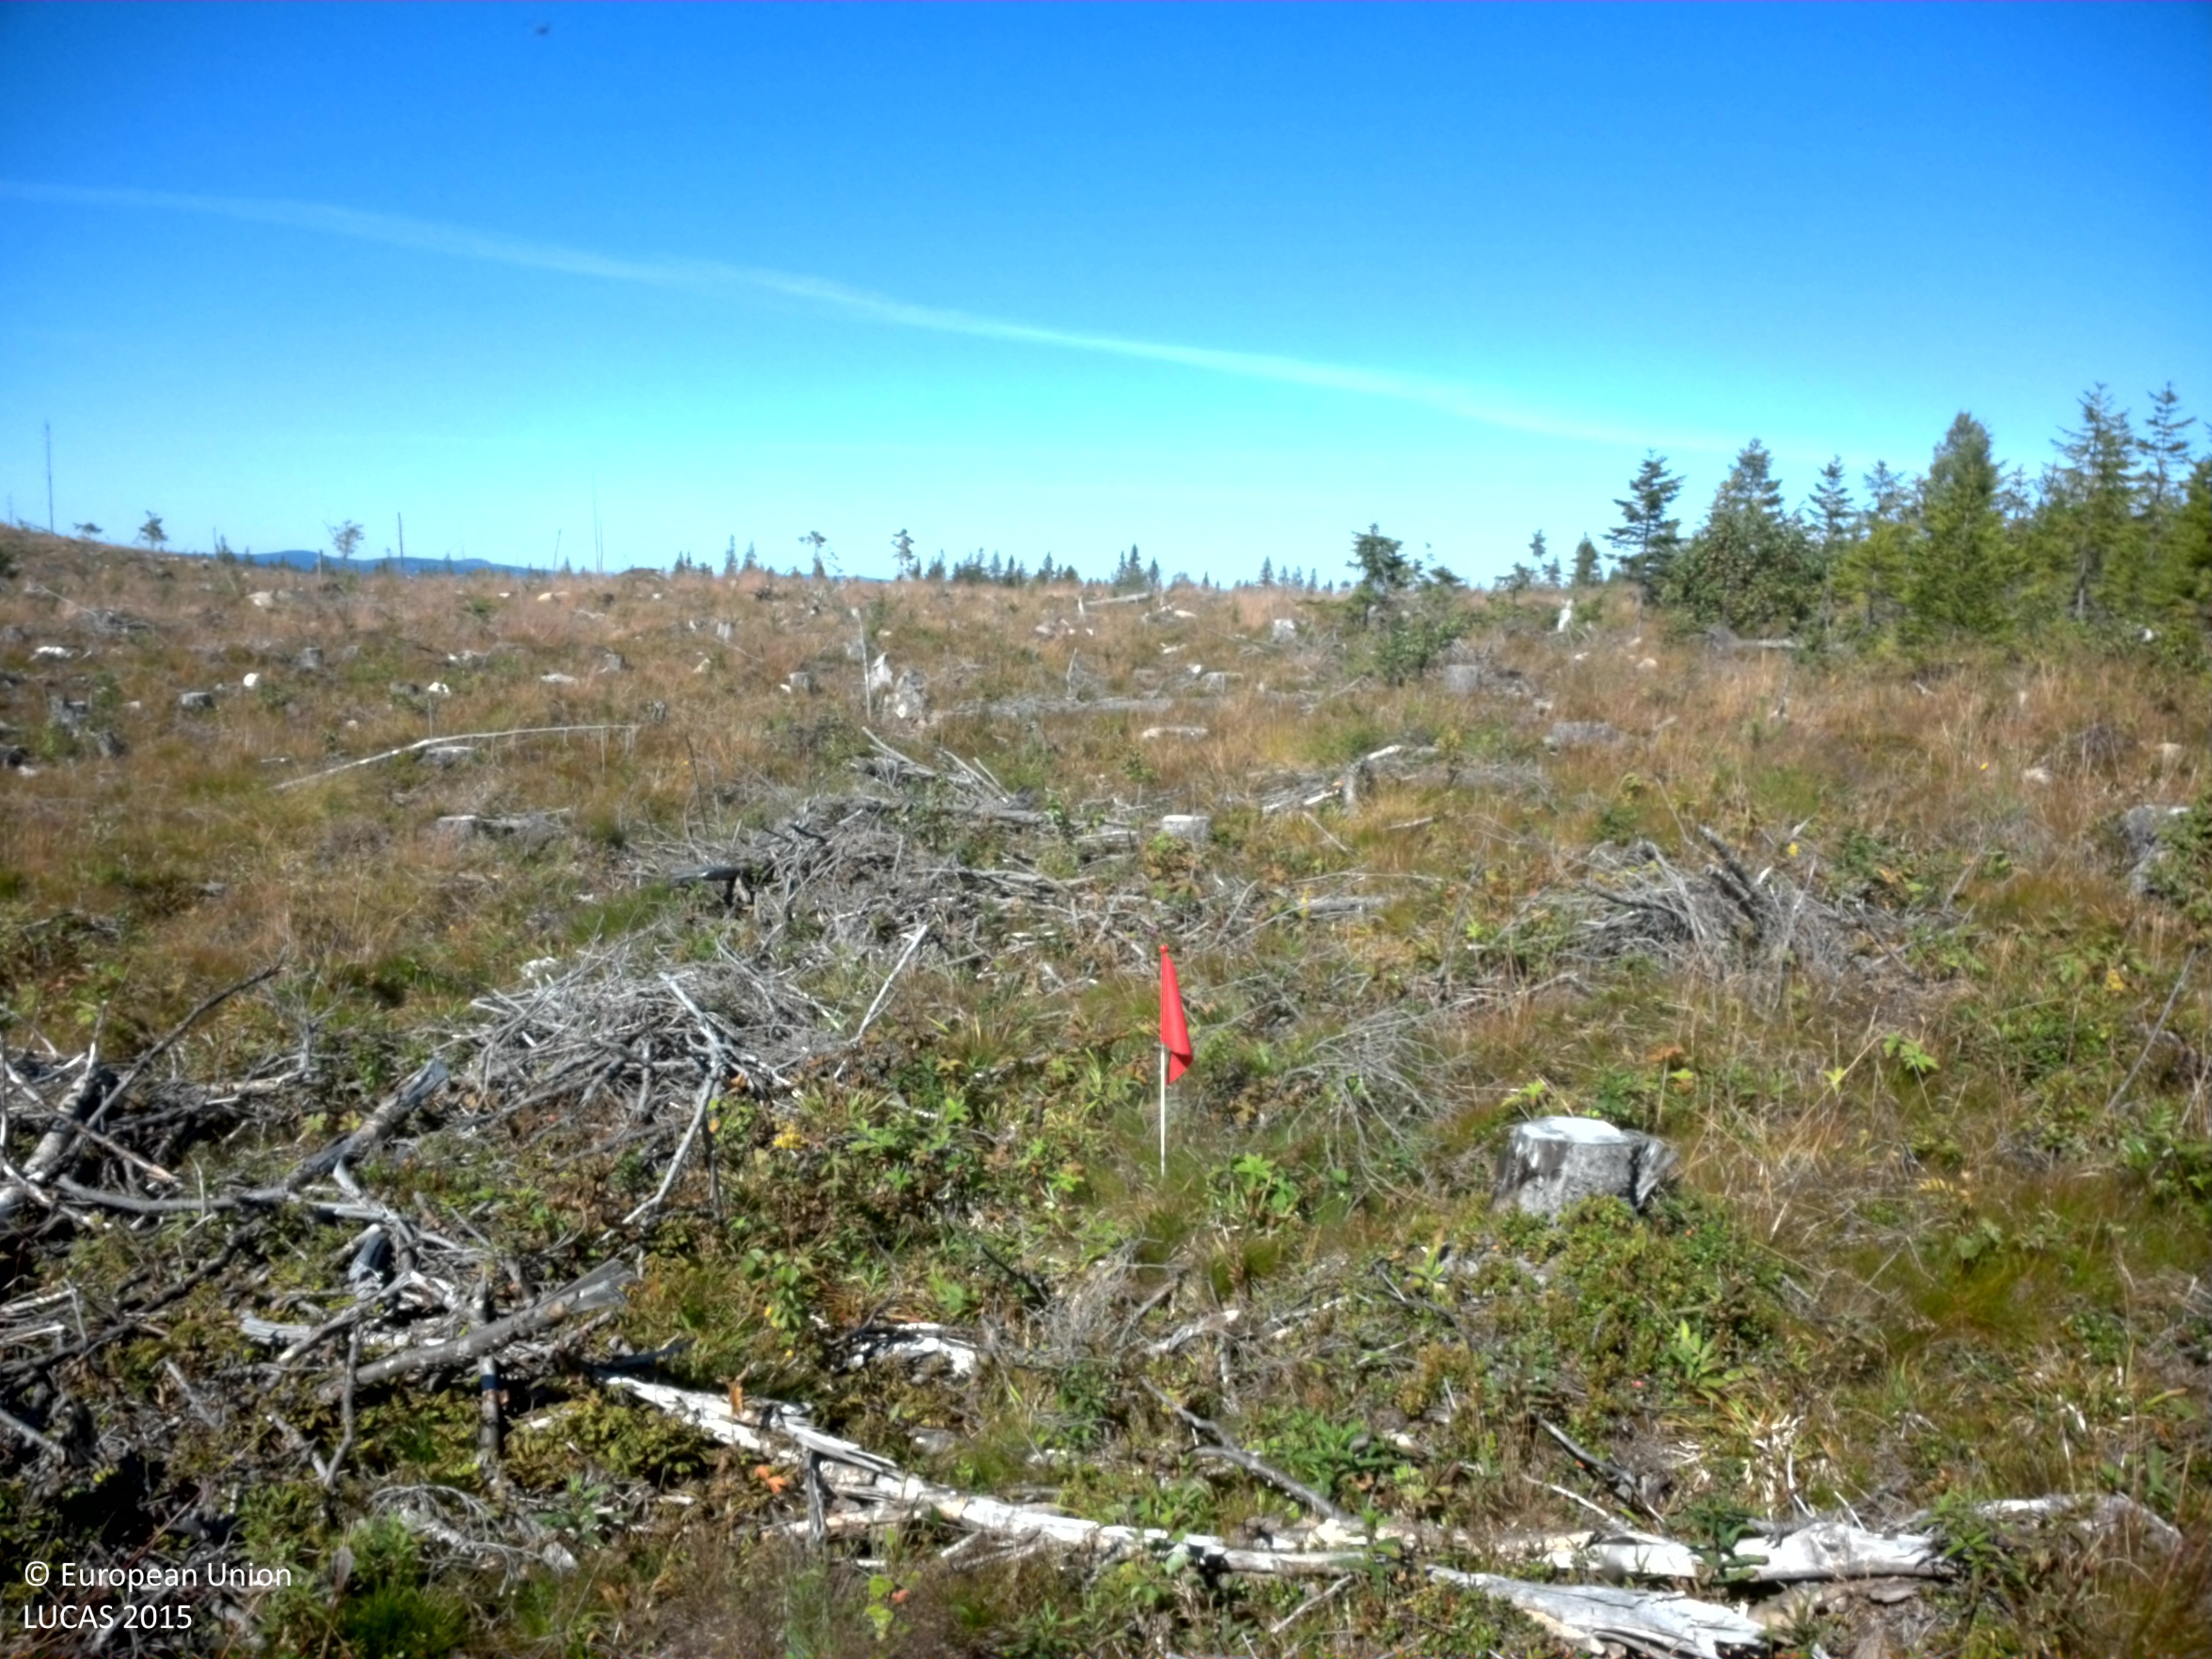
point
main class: Grassland
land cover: Grassland with sparse tree/shrub cover
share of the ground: > 75 %
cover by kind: herbaceous plants 85 %, shrubs 10 %, broadleaved forest trees 5 %
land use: Forestry
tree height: < 5 m
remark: Clear cut
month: August
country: SE
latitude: 64.3039
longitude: 18.7141
